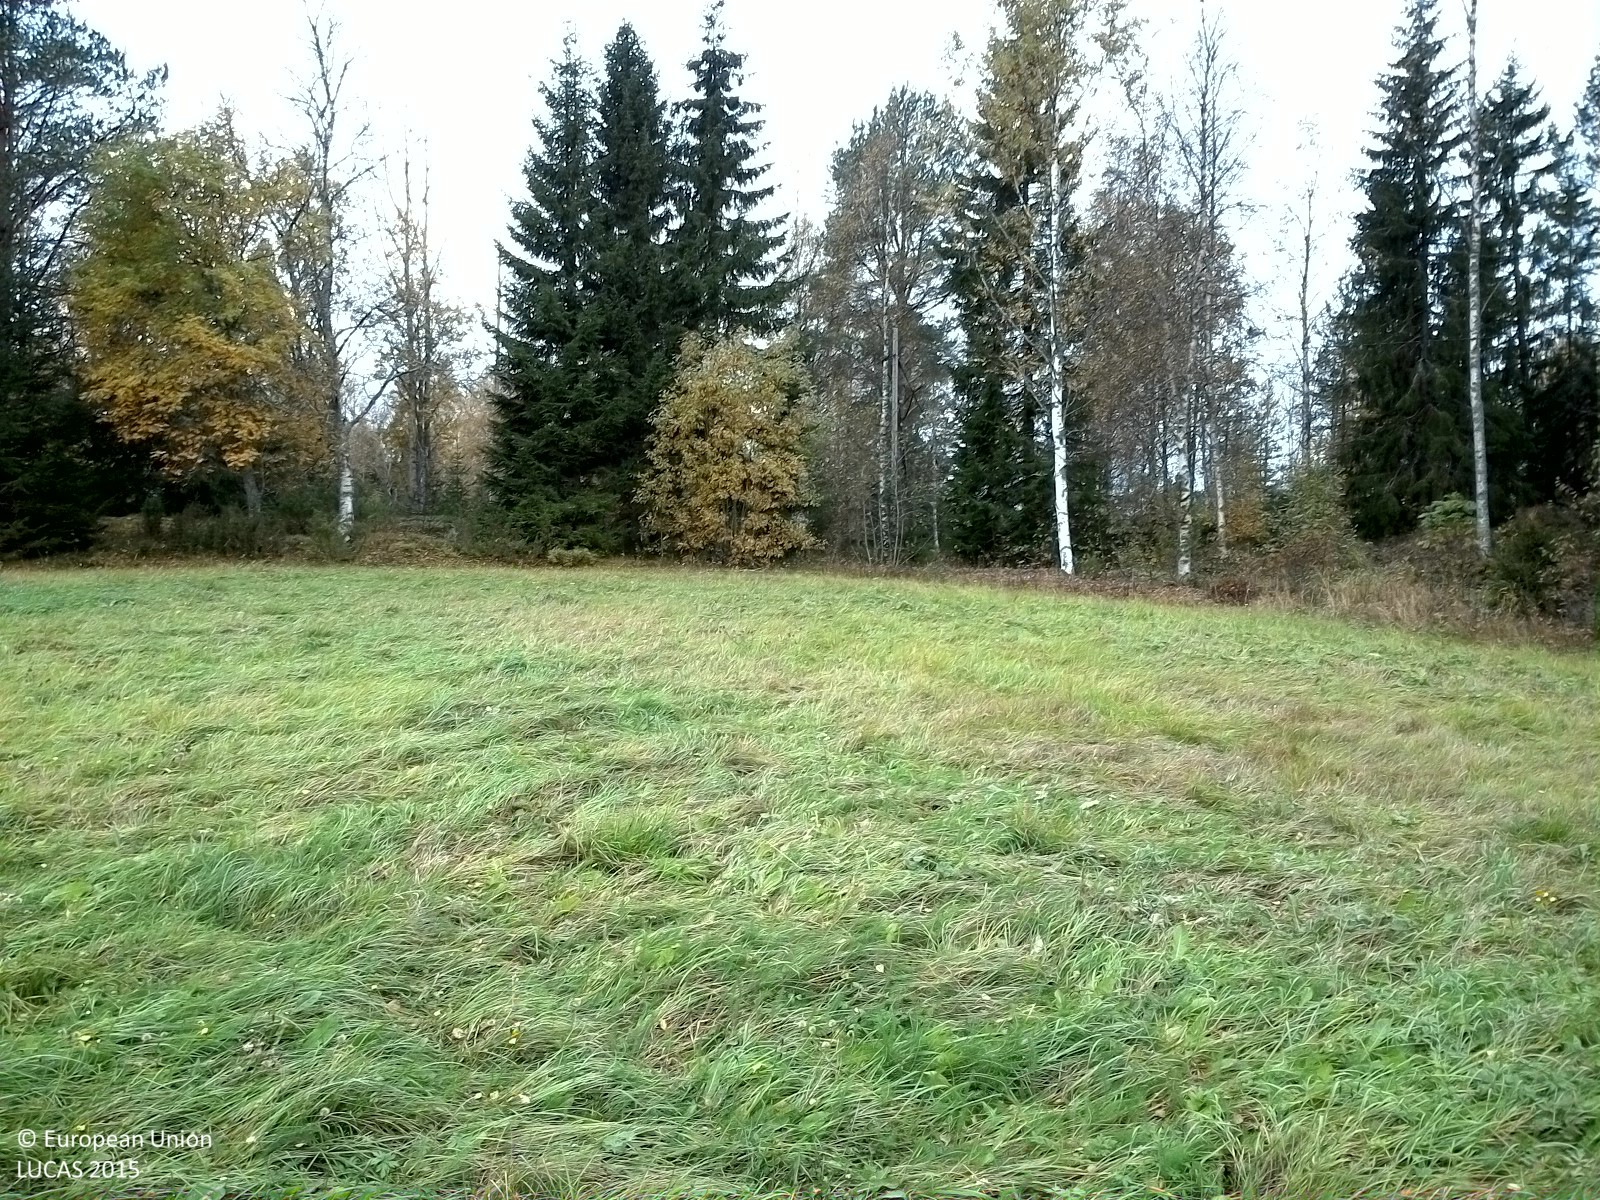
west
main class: Grassland
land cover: Grassland without tree/shrub cover
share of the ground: > 75 %
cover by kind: herbaceous plants 100 %
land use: Amenities, museums, leisure
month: October
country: SE
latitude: 62.6297
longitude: 17.7593
